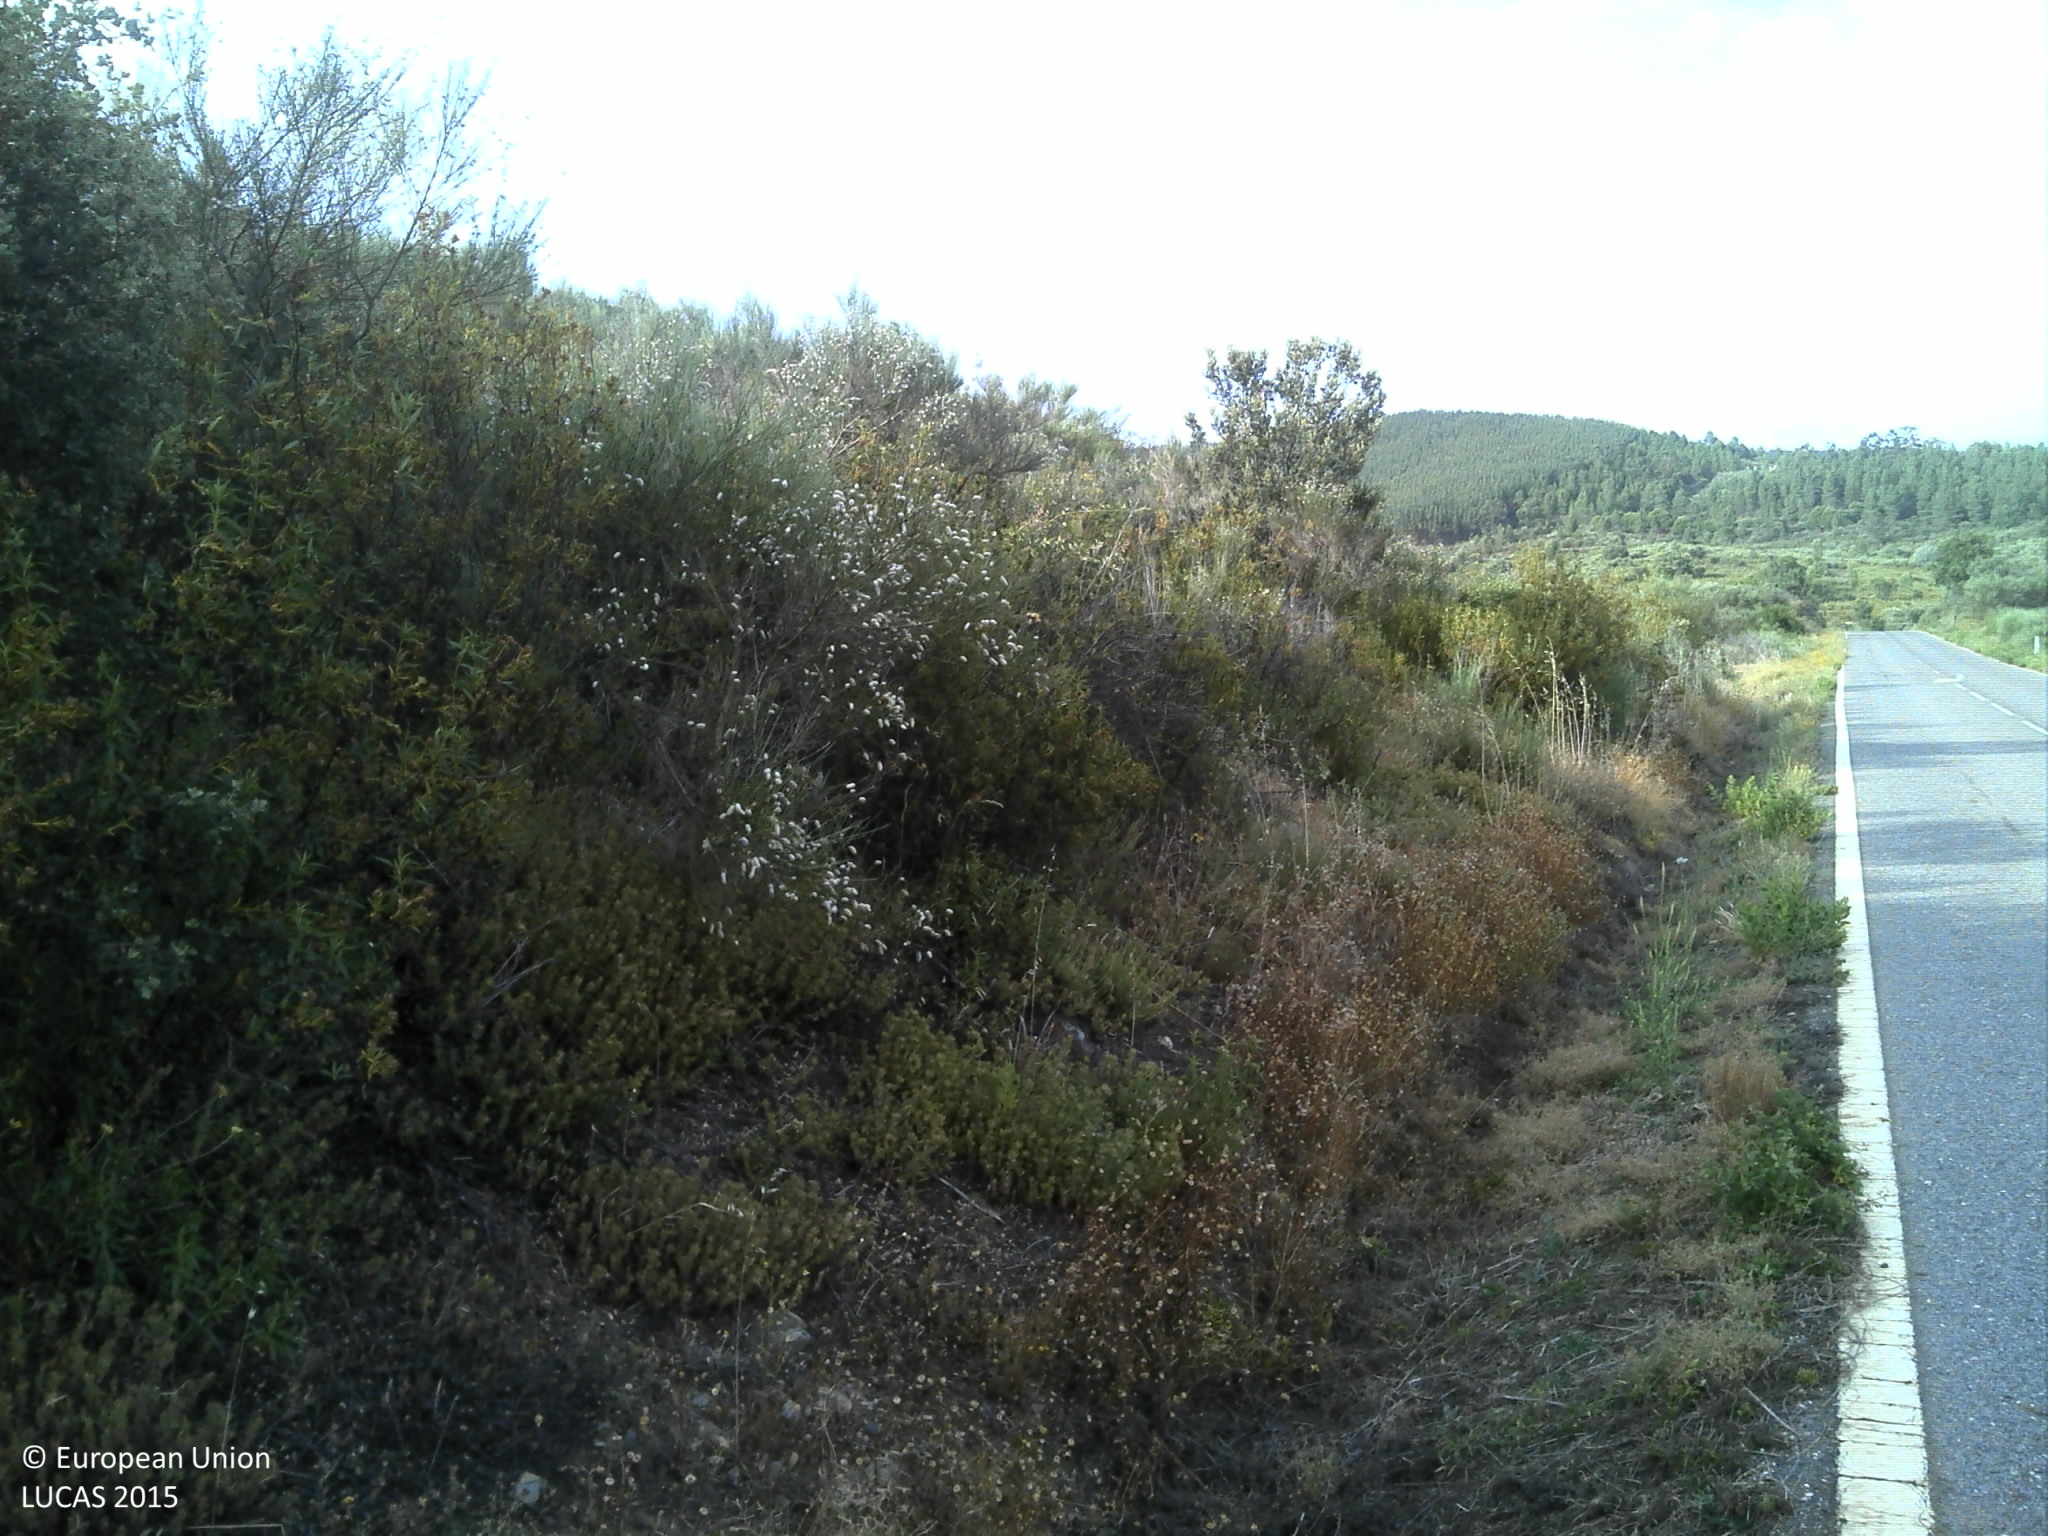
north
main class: Shrubland
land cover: Shrubland with sparse tree cover
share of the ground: > 75 %
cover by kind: shrubs 80 %, broadleaved forest trees 5 %, herbaceous plants 5 %, unconsolidated bare surface 5 %
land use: Semi-natural and natural areas not in use
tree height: < 5 m
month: June
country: PT
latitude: 40.2554
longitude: -7.1582
